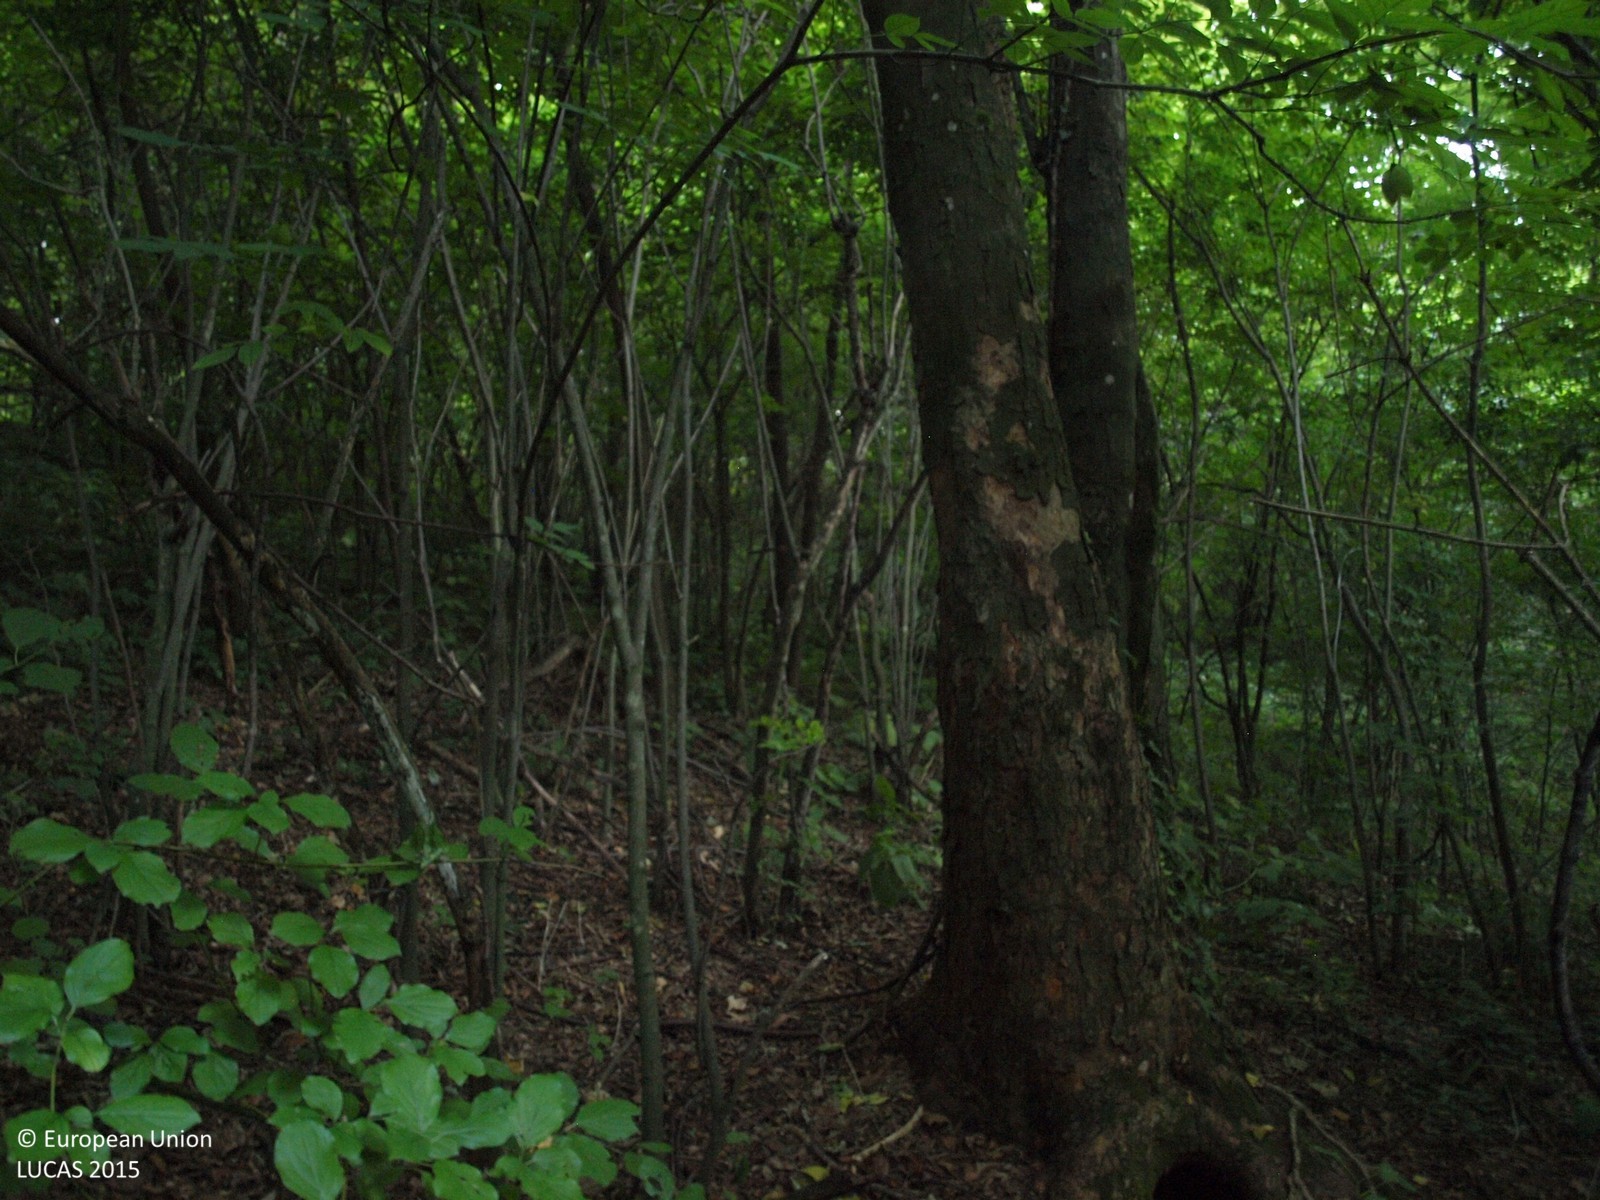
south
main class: Woodland
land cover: Broadleaved woodland
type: beech forest
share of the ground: > 75 %
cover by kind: broadleaved forest trees 100 %
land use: Forestry
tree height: > 5 m
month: July
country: HR
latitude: 46.2196
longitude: 16.5992
